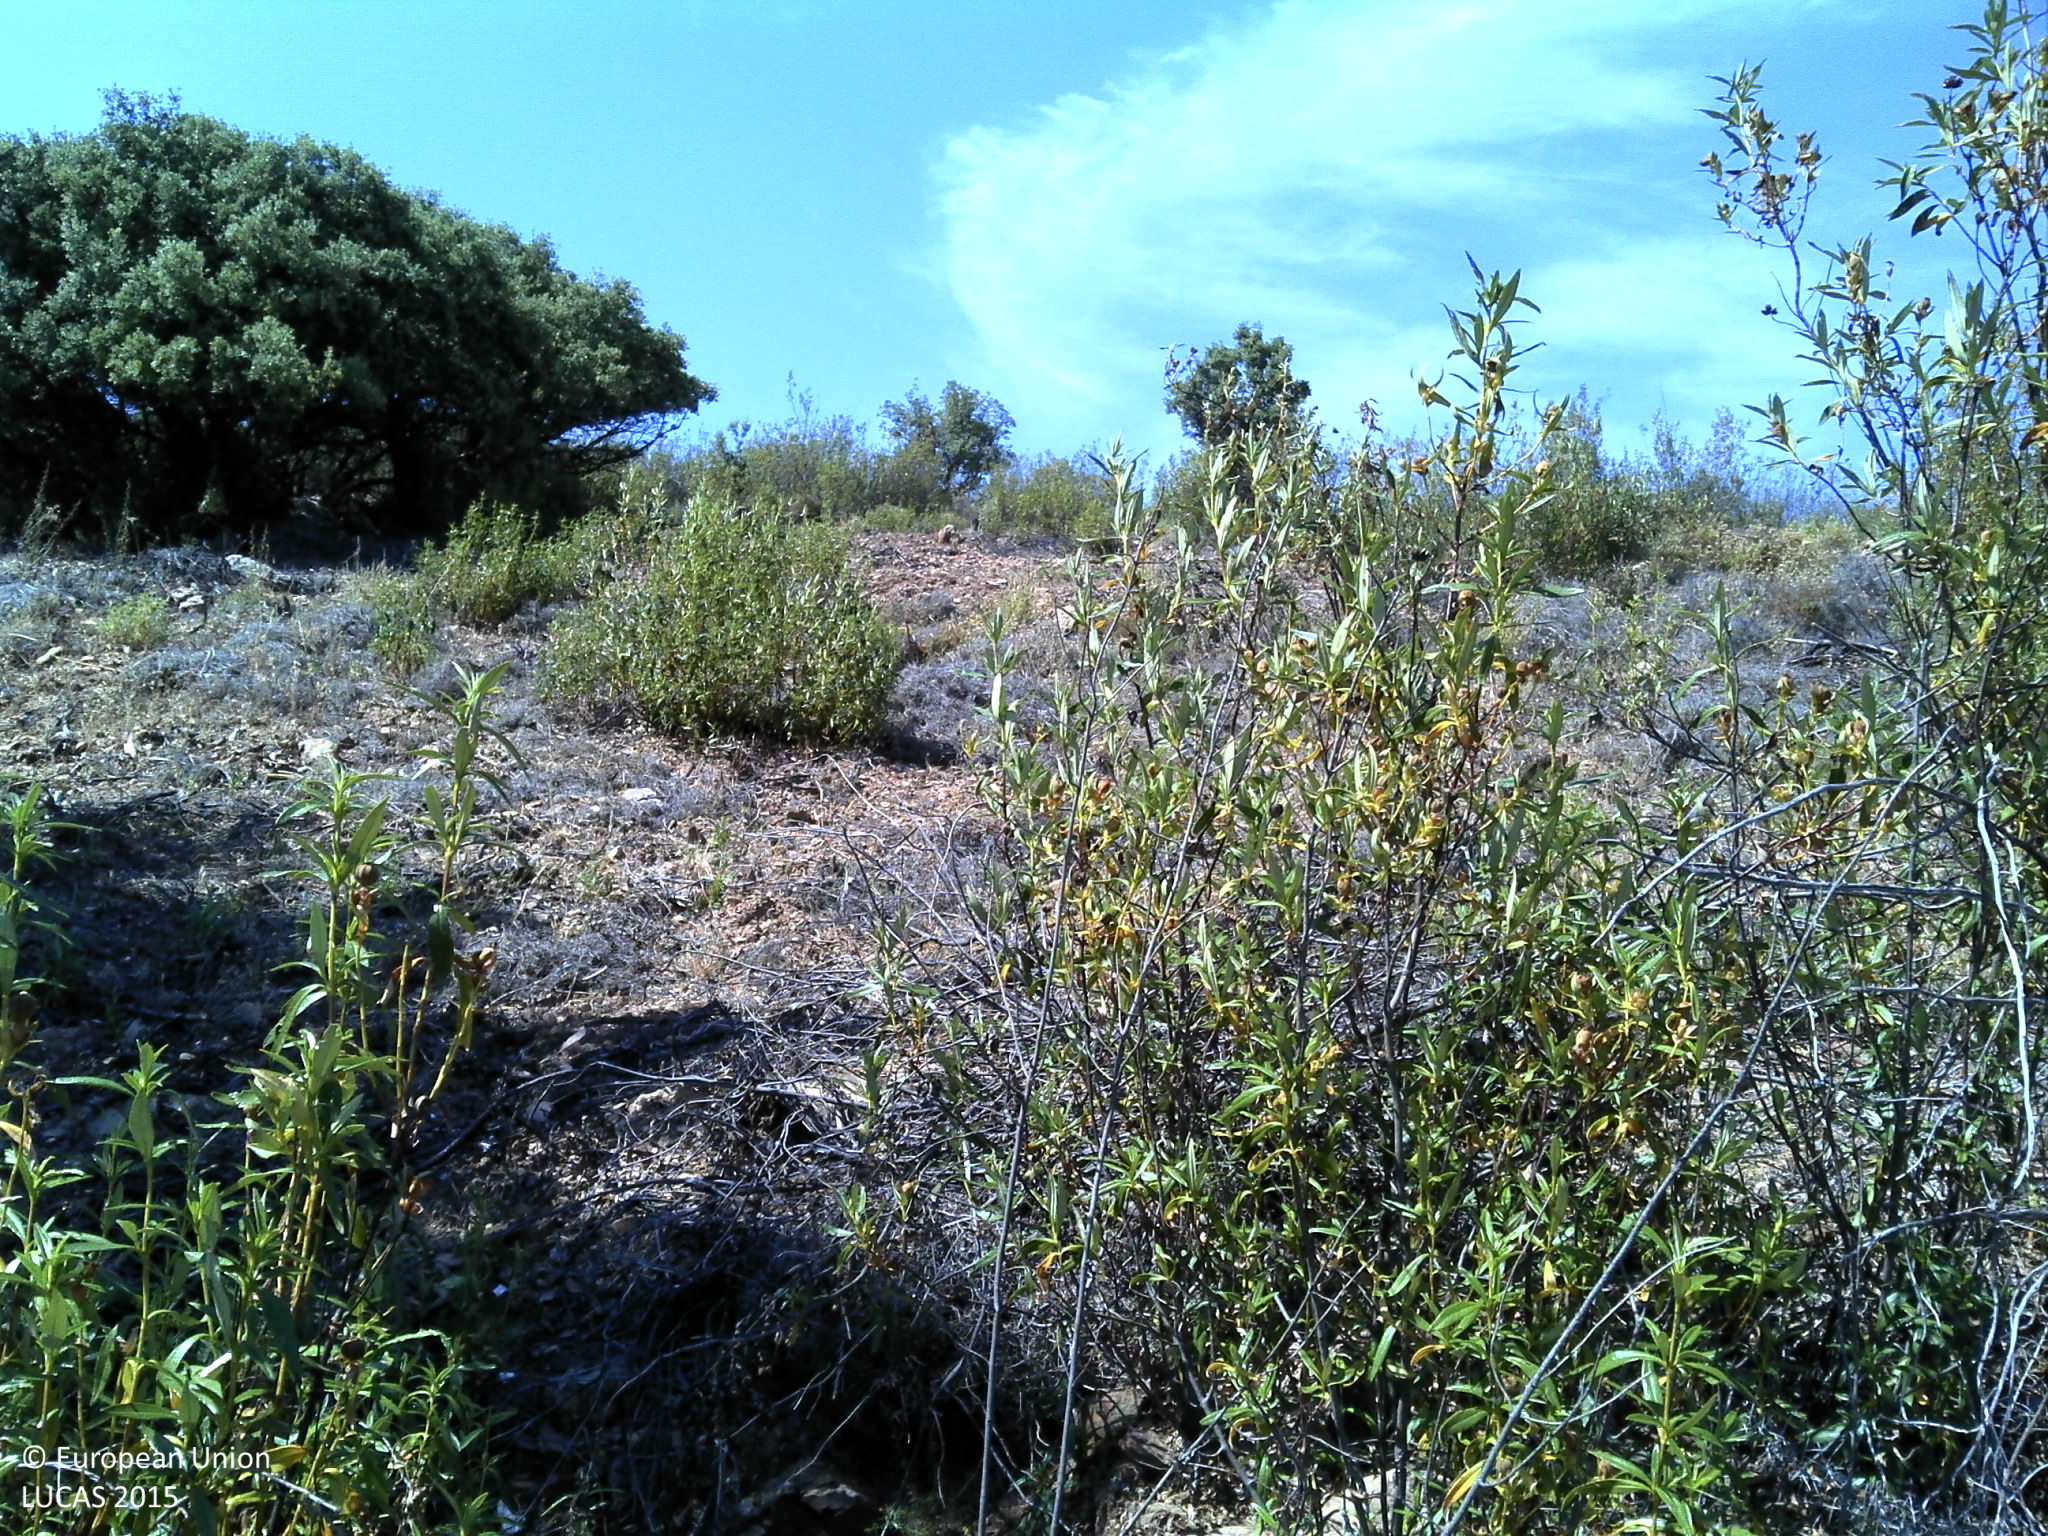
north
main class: Shrubland
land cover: Shrubland with sparse tree cover
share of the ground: 10 - 25 %
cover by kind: unconsolidated bare surface 60 %, shrubs 20 %, herbaceous plants 15 %, broadleaved forest trees 5 %
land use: Agriculture (excluding fallow land and kitchen gardens)
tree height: > 5 m
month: June
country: PT
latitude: 37.6501
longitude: -7.4779
